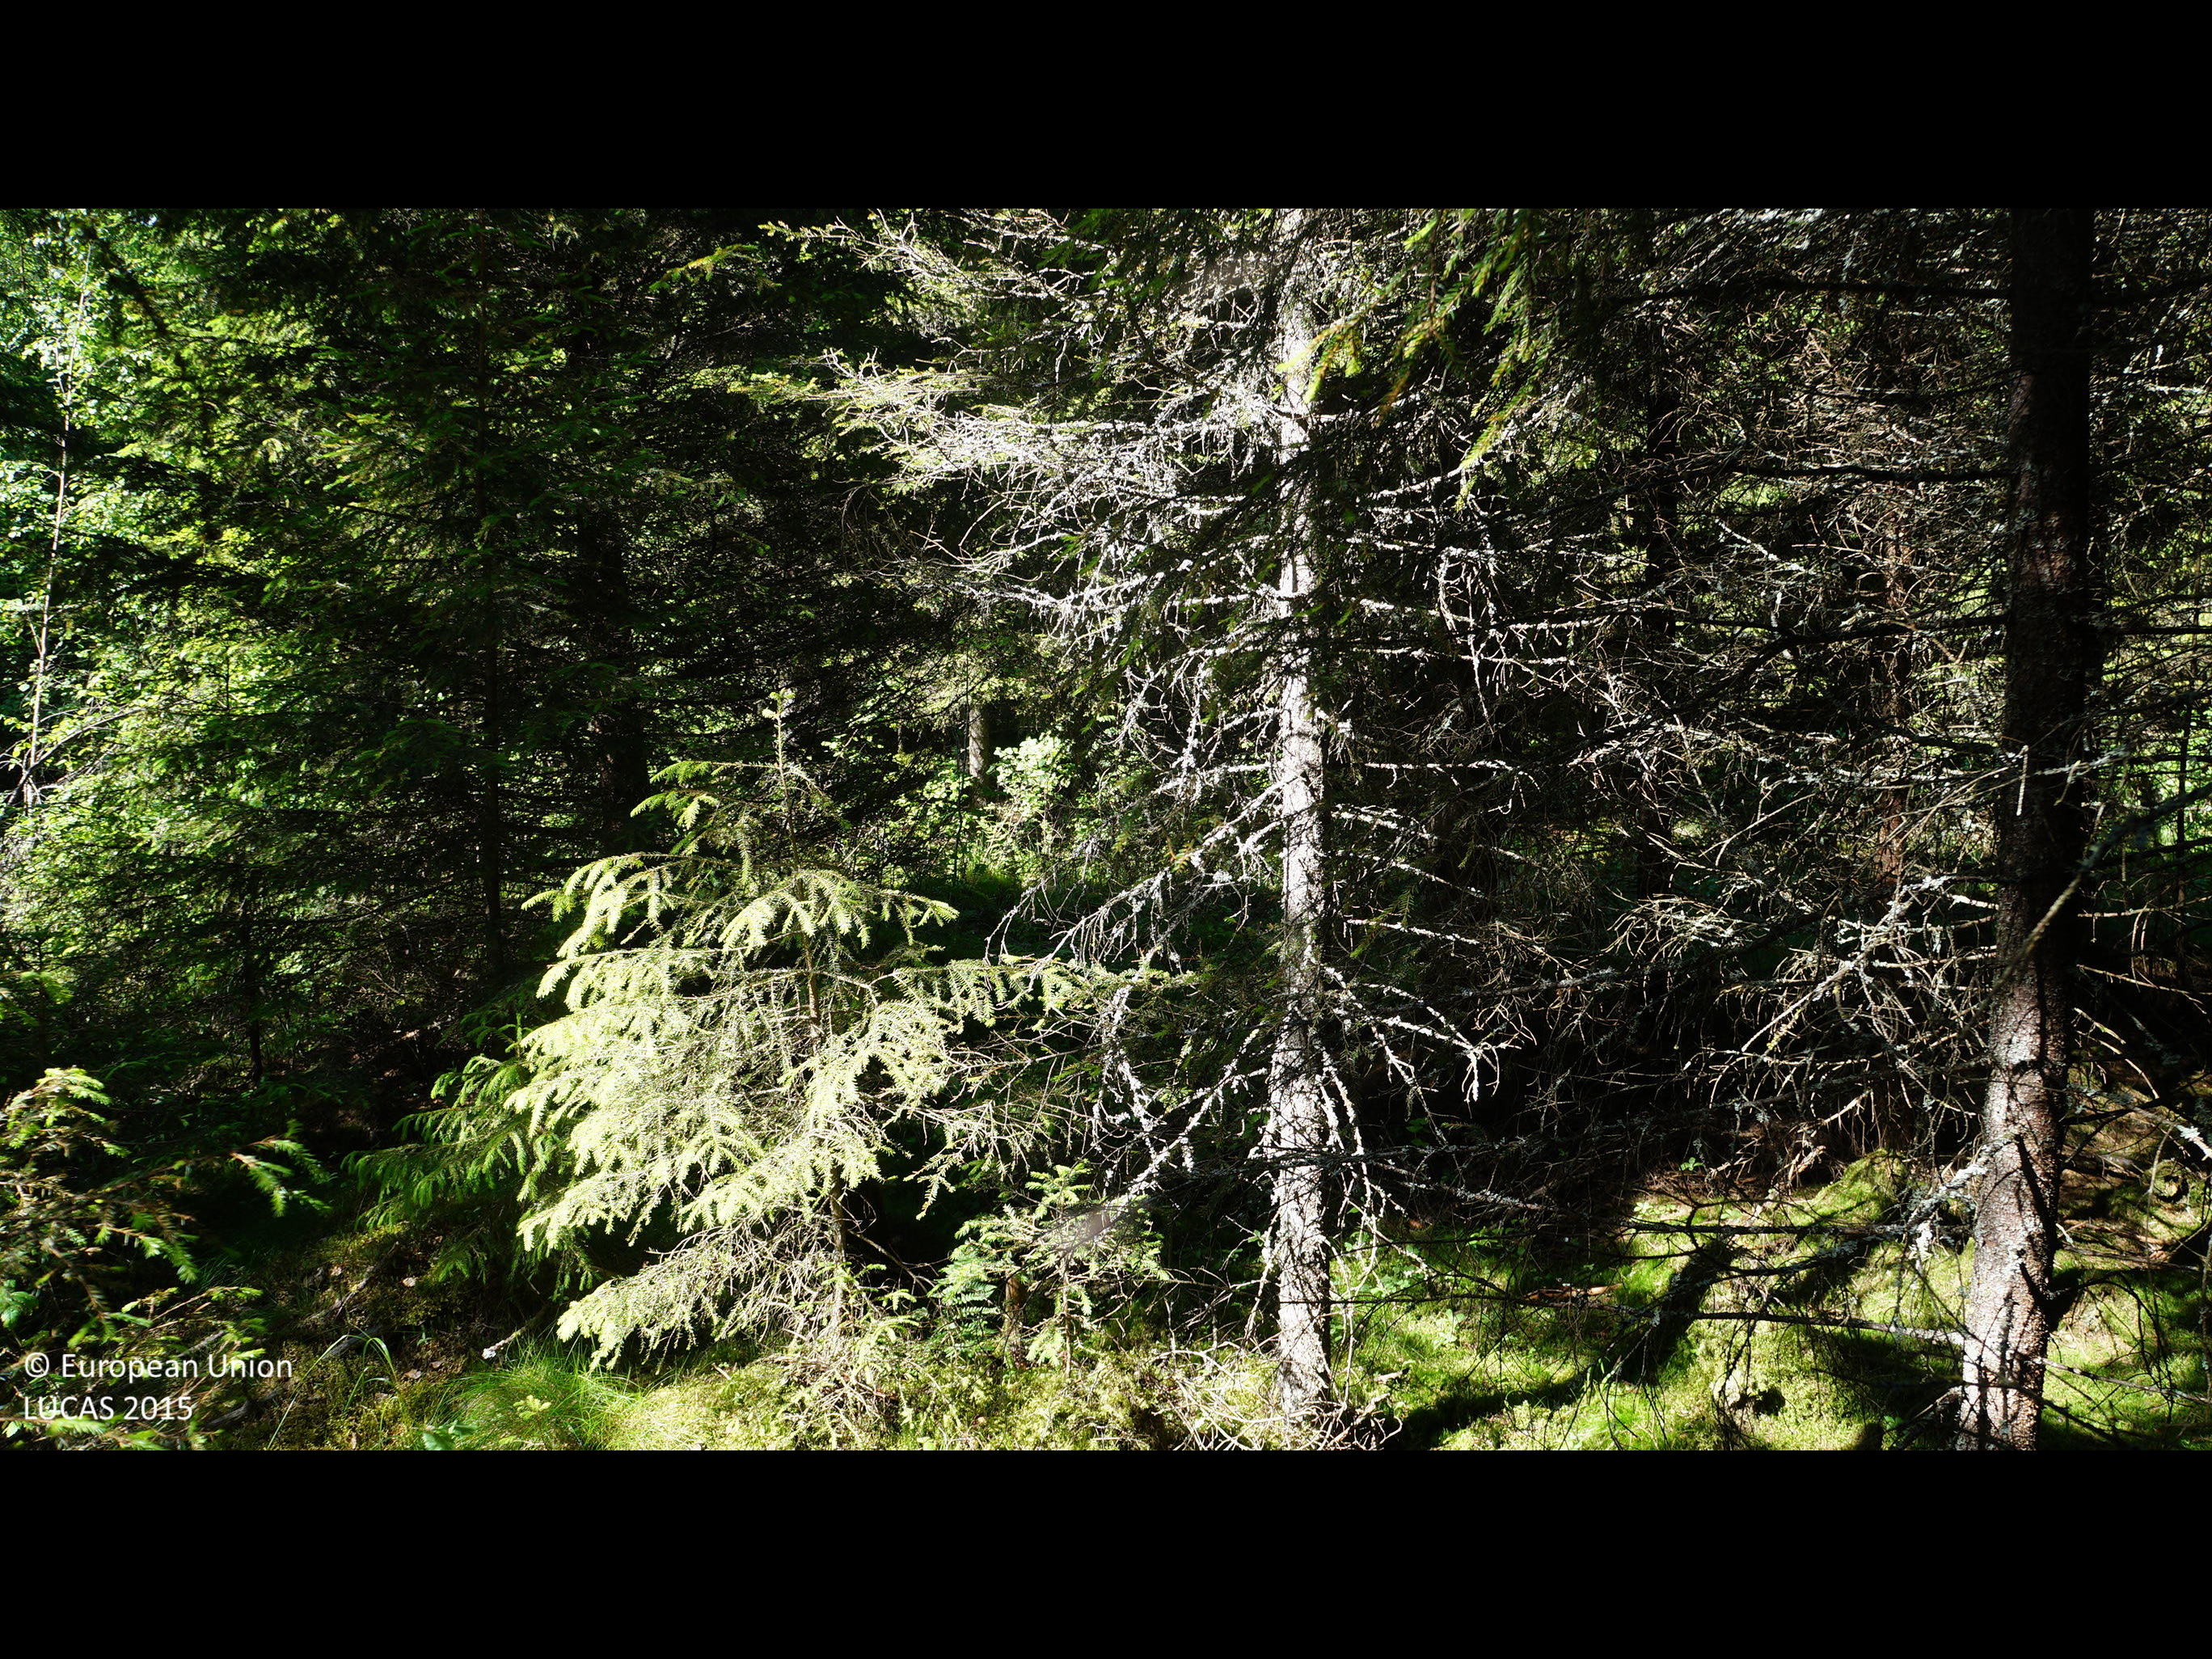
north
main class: Woodland
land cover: Spruce dominated coniferous woodland
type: boreal forest
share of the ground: > 75 %
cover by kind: coniferous forest trees 80 %, lichens and mosses 10 %, shrubs 5 %, herbaceous plants 5 %
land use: Forestry
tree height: > 5 m
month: July
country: FI
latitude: 64.2342
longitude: 24.4001
